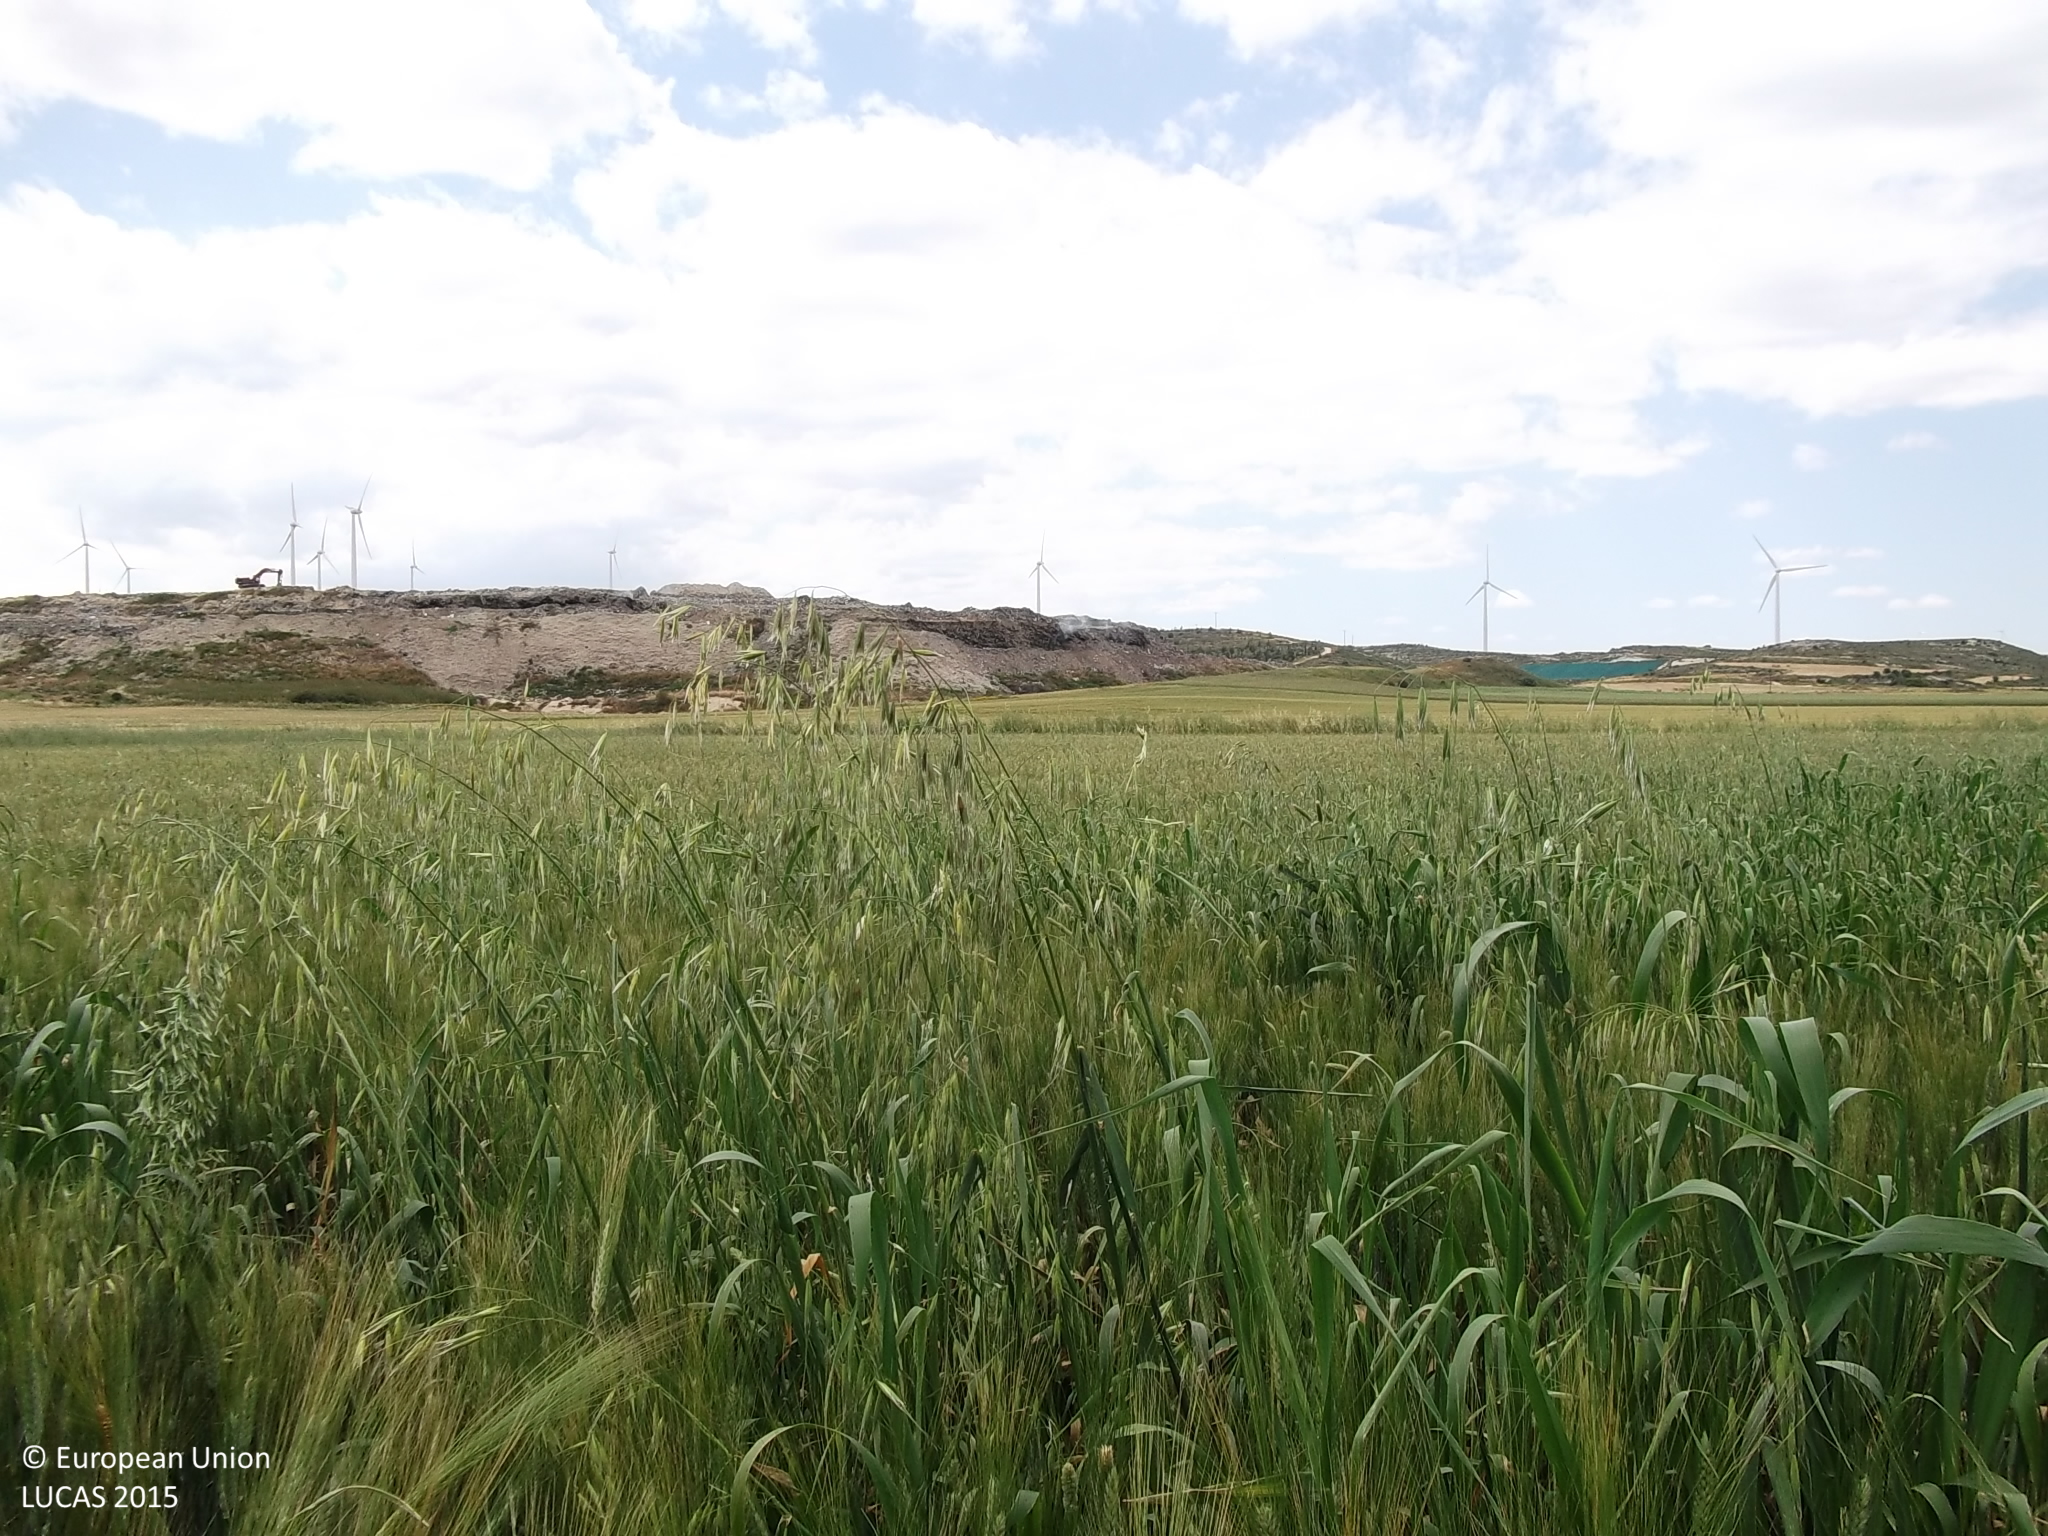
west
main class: Cropland
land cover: Barley
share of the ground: > 75 %
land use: Agriculture (excluding fallow land and kitchen gardens)
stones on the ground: < 10 %
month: April
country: CY
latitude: 34.8769
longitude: 33.5495
